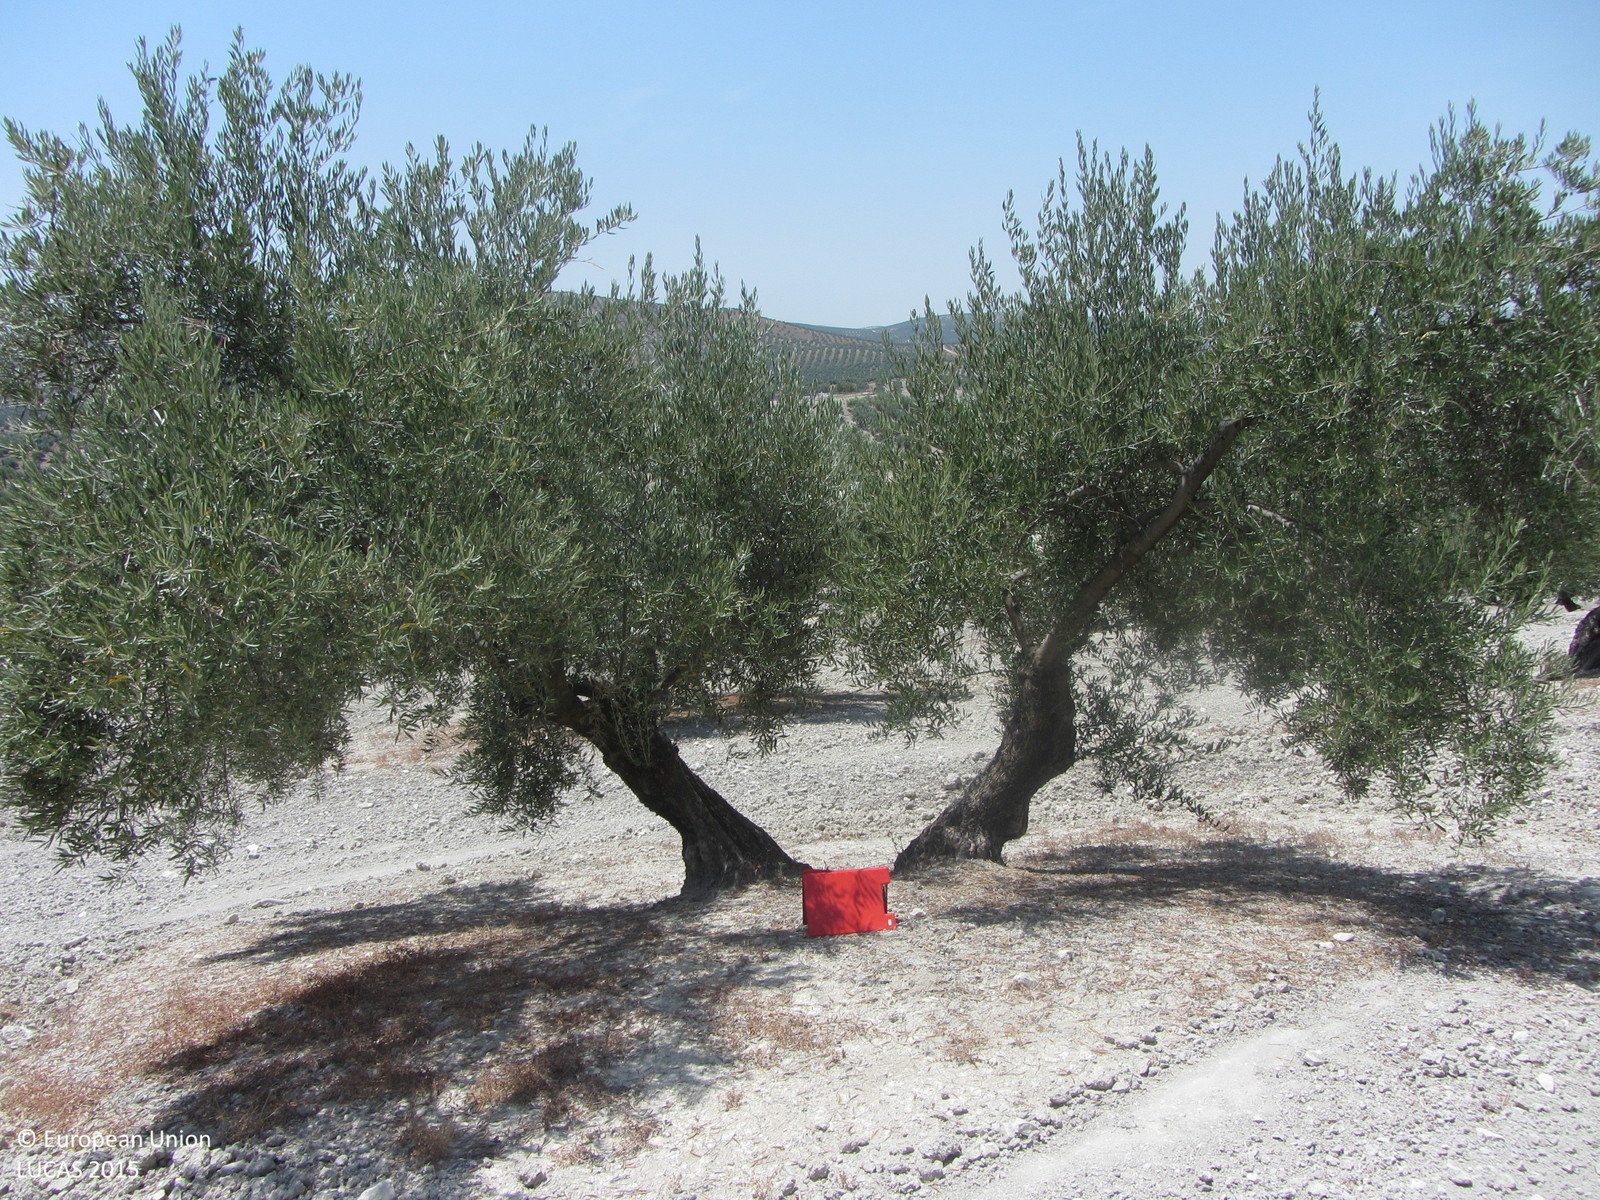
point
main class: Cropland
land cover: Olive groves
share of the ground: 25 - 50 %
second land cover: Other bare soil
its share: > 75 %
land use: Agriculture (excluding fallow land and kitchen gardens)
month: July
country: ES
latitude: 37.7484
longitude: -4.1569
